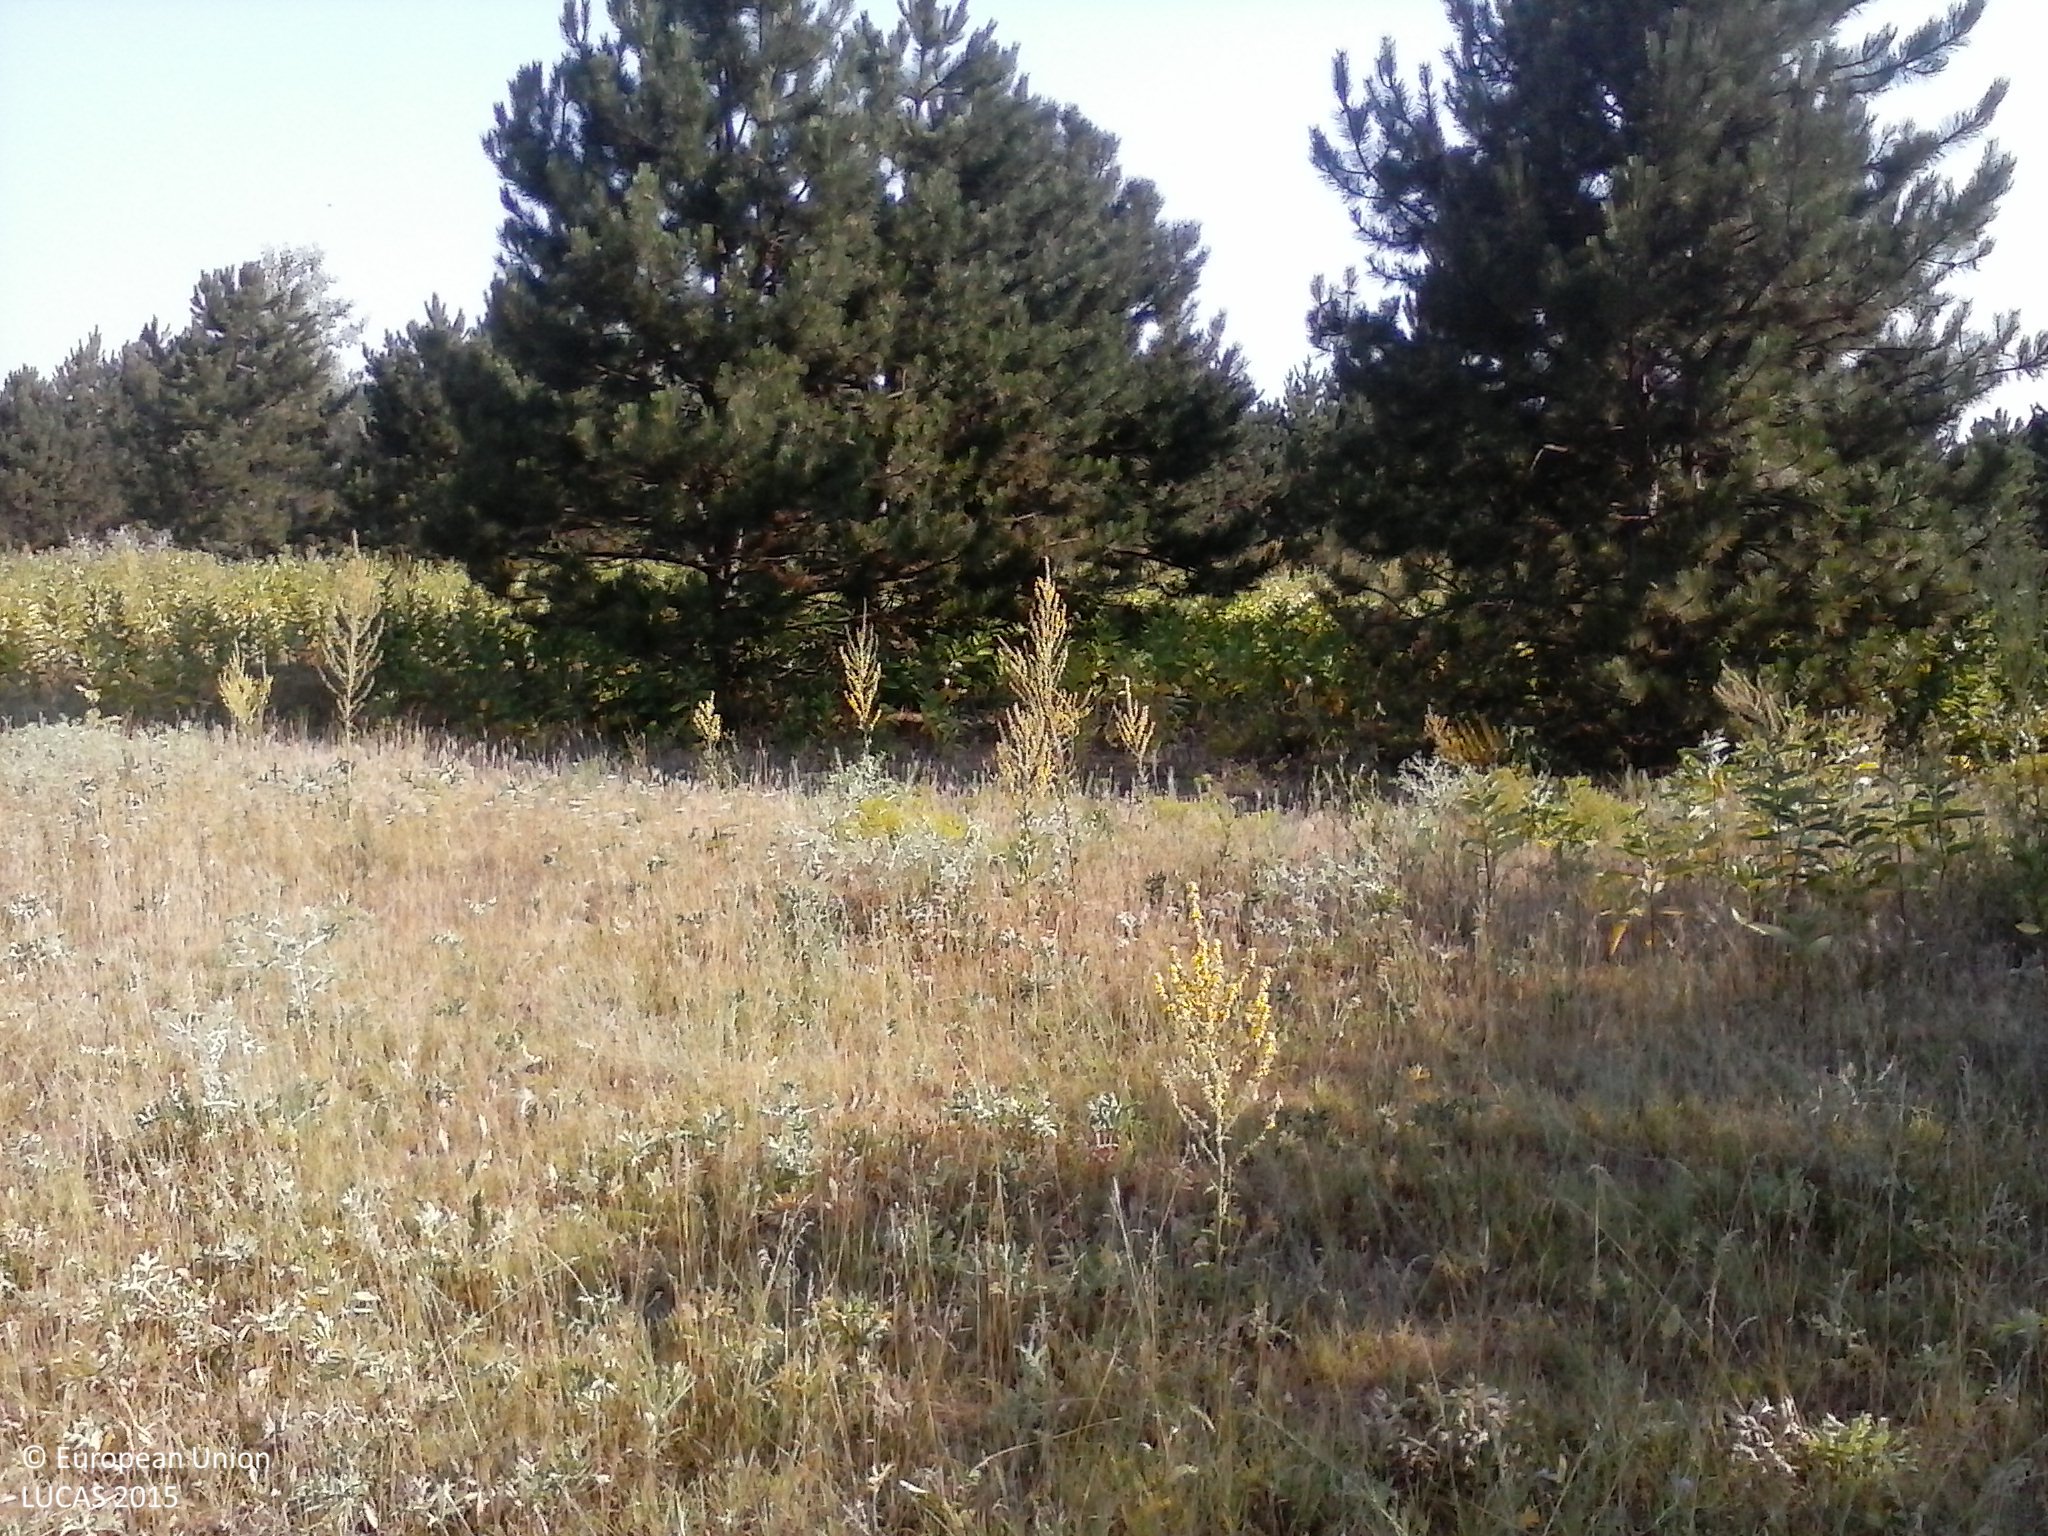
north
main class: Grassland
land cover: Spontaneously vegetated surfaces
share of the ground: > 75 %
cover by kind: herbaceous plants 100 %
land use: Agriculture (excluding fallow land and kitchen gardens)
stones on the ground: < 10 %
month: July
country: HU
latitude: 46.4363
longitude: 19.6889
